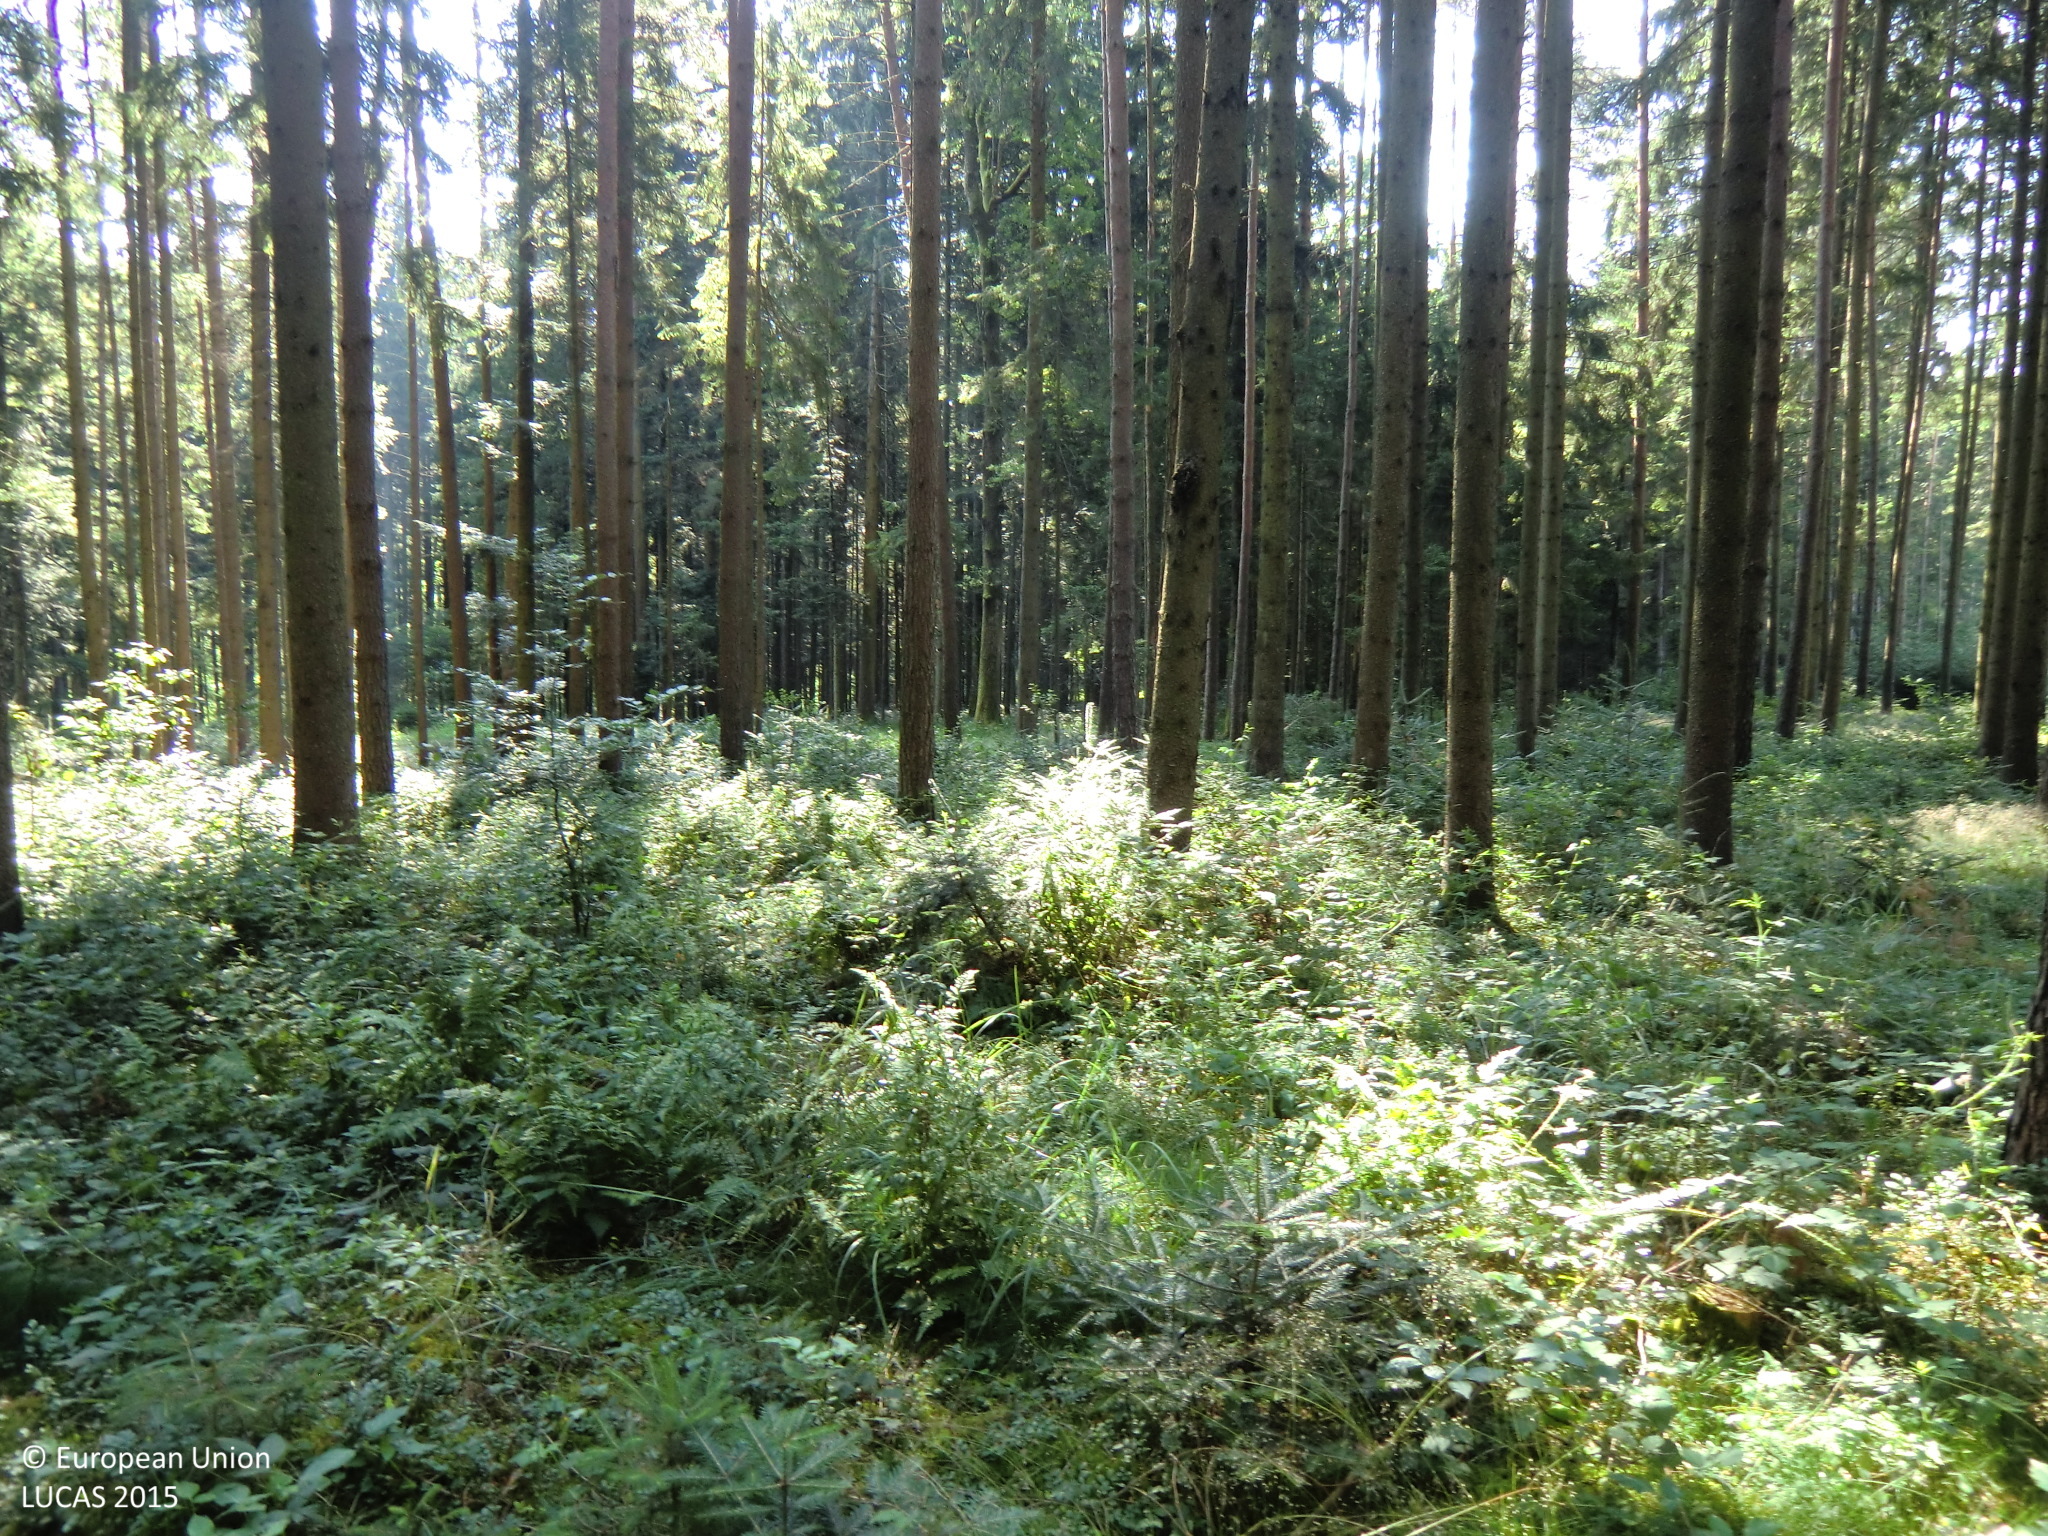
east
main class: Woodland
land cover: Spruce dominated coniferous woodland
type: hemiboreal forest and nemoral coniferous forest and mixed broadleaved-coniferous forest
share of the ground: > 75 %
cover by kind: coniferous forest trees 75 %, shrubs 15 %, herbaceous plants 10 %
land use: Forestry
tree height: > 5 m
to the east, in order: Spruce dominated coniferous woodland; Tracks; Spruce dominated coniferous woodland; Tracks; Spruce dominated coniferous woodland; Rivers and streams; Broadleaved woodland; Rape and turnip rape; Maize
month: July
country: AT
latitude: 47.2502
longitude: 15.9605
